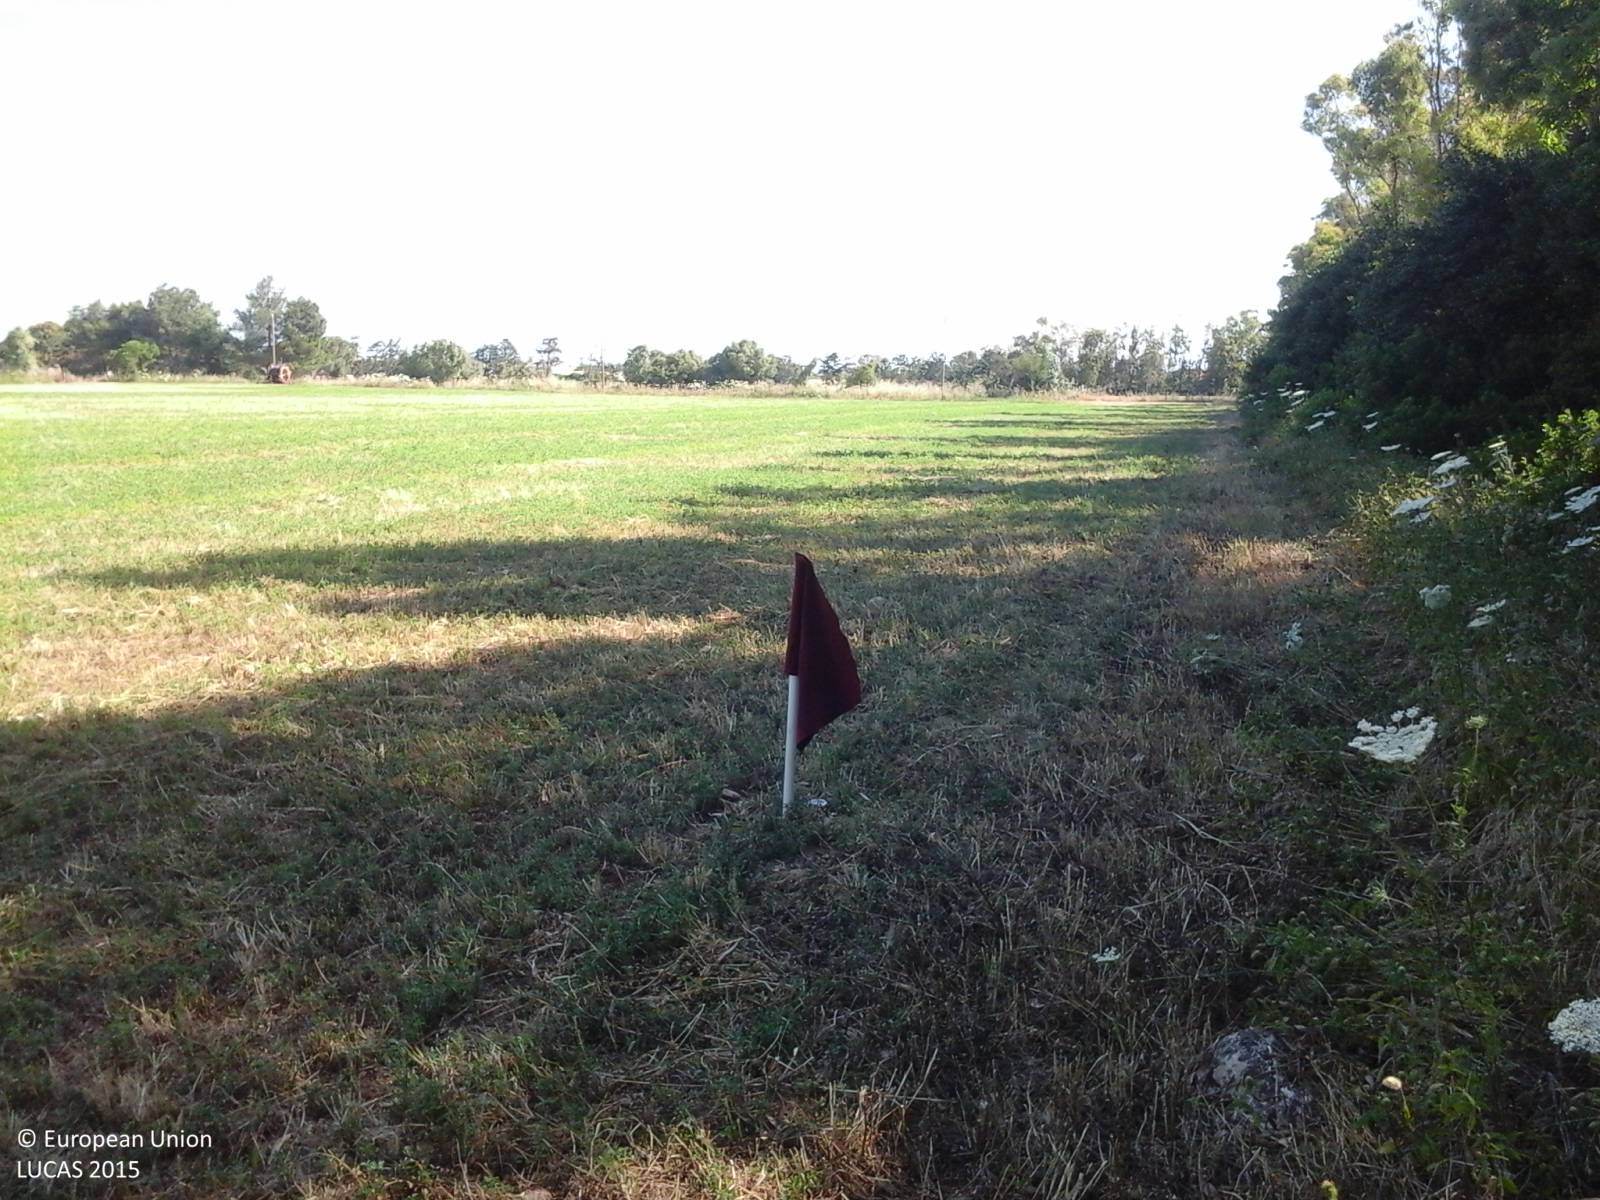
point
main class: Cropland
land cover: Lucerne
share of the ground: 50 - 75 %
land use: Agriculture (excluding fallow land and kitchen gardens)
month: June
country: IT
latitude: 40.6704
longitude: 8.3871
